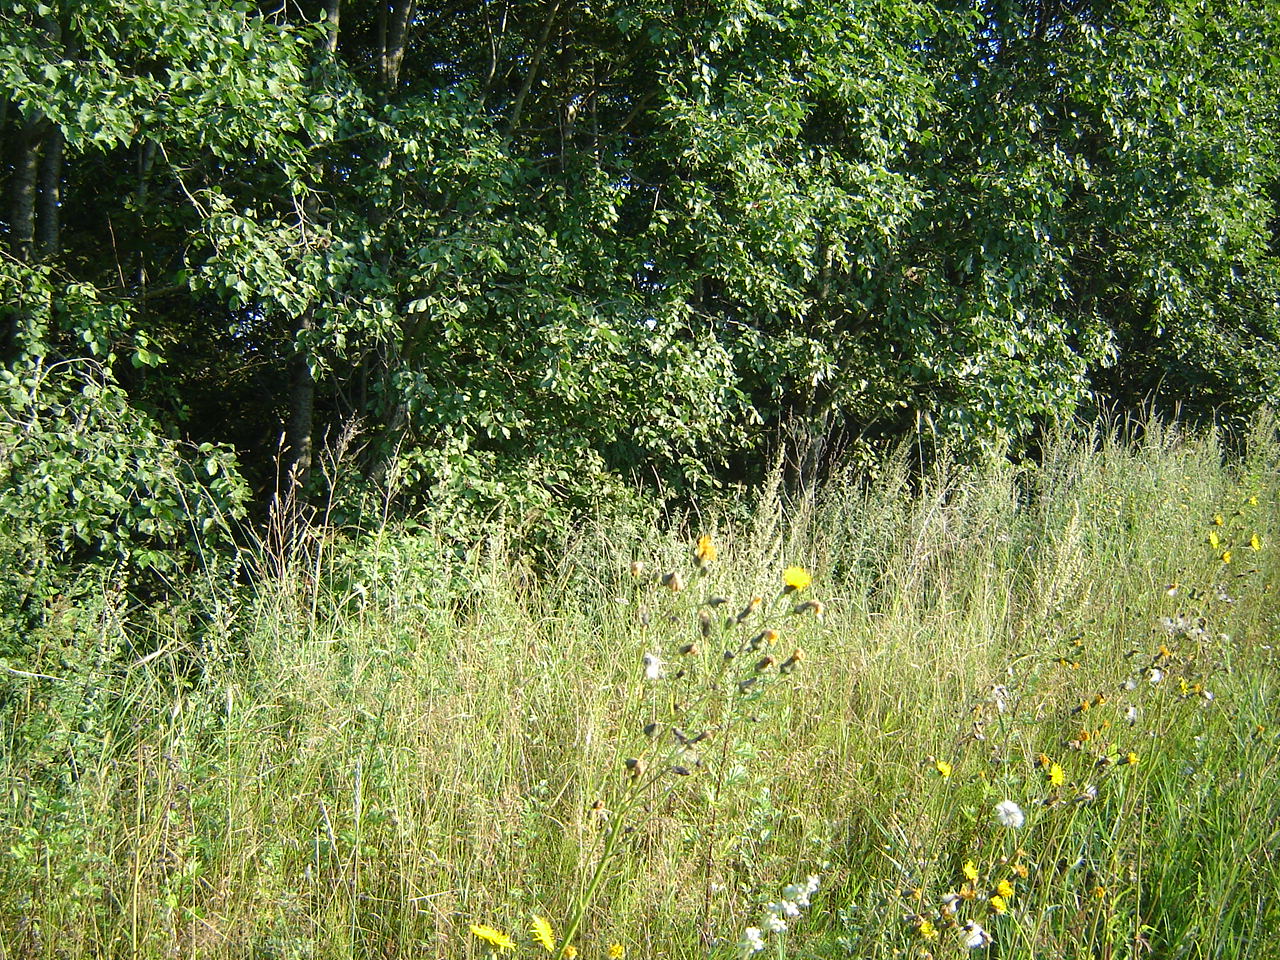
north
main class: Grassland
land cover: Grassland without tree/shrub cover
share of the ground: > 75 %
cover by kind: herbaceous plants 90 %, unconsolidated bare surface 10 %
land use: Agriculture (excluding fallow land and kitchen gardens)
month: August
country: LT
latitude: 55.2104
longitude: 25.1241
